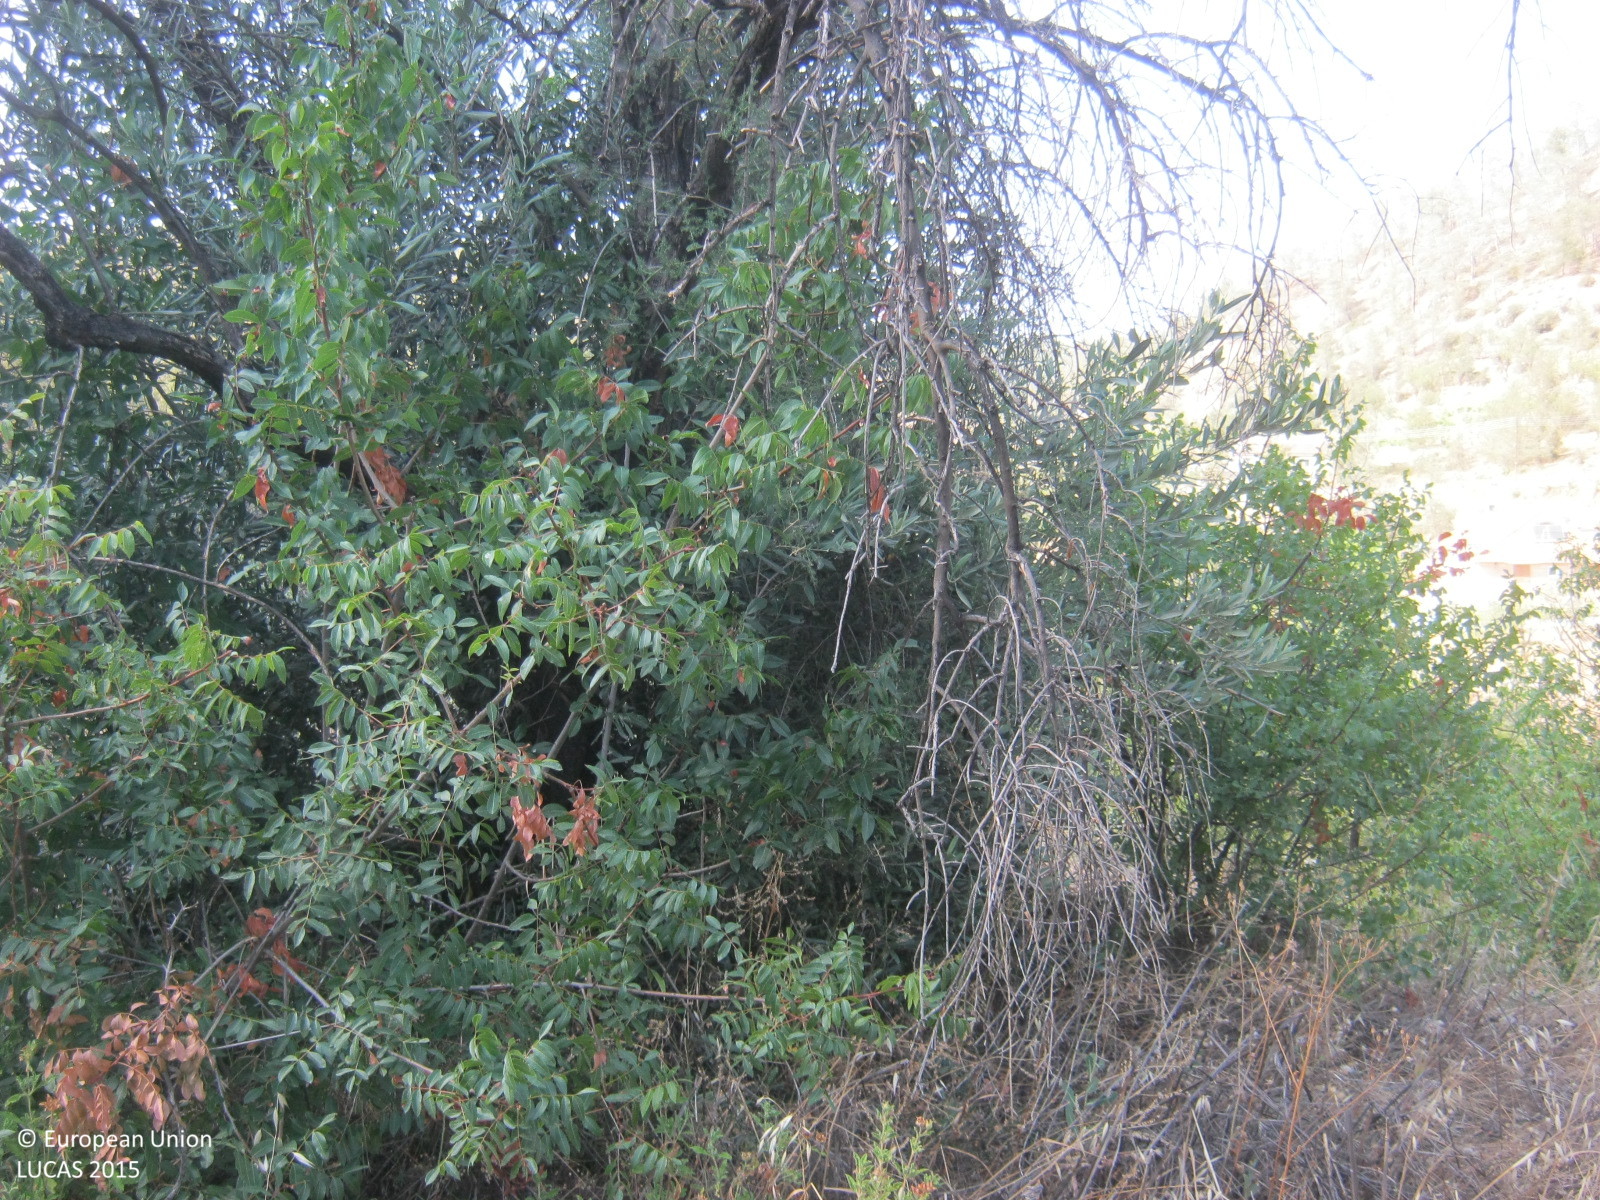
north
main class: Cropland
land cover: Olive groves
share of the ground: 25 - 50 %
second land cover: Shrubland without tree cover
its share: > 75 %
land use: Abandoned areas
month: June
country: CY
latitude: 34.9860
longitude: 33.1290
